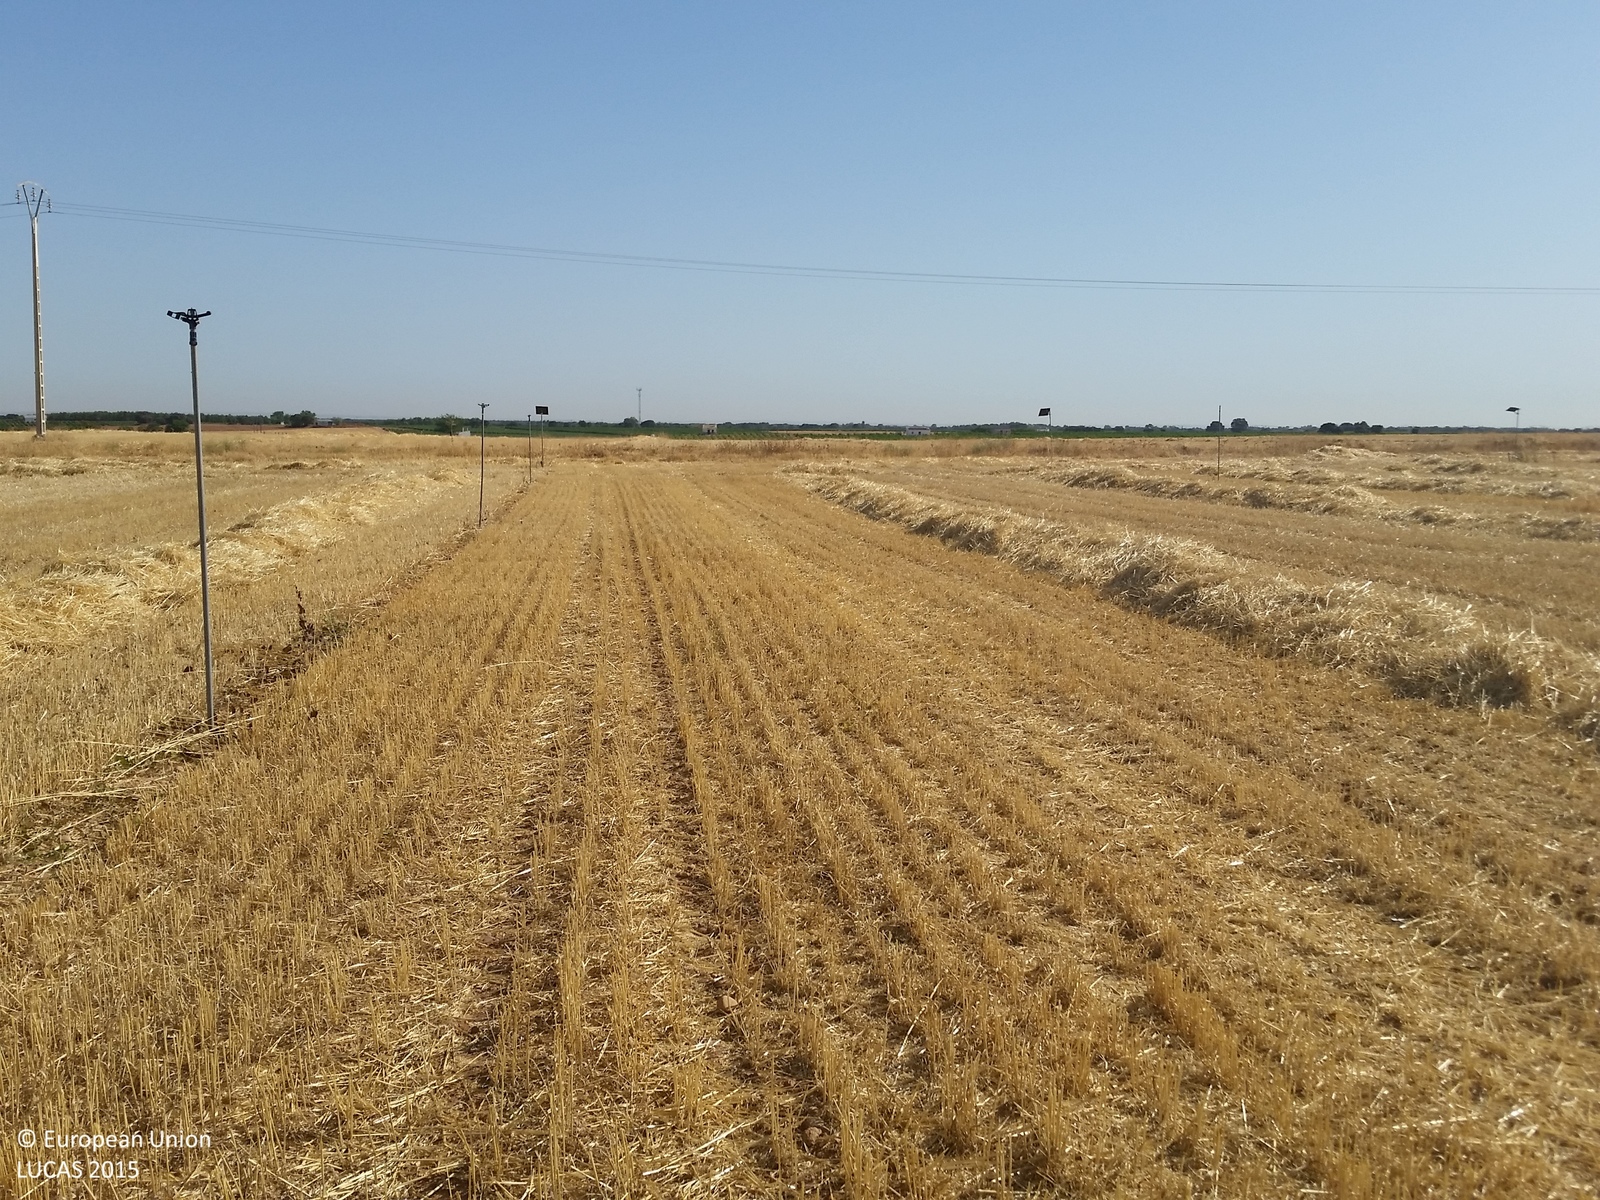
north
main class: Cropland
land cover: Common wheat
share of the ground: < 10 %
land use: Agriculture (excluding fallow land and kitchen gardens)
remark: Harvested field
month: July
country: ES
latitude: 39.2732
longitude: -2.7037
